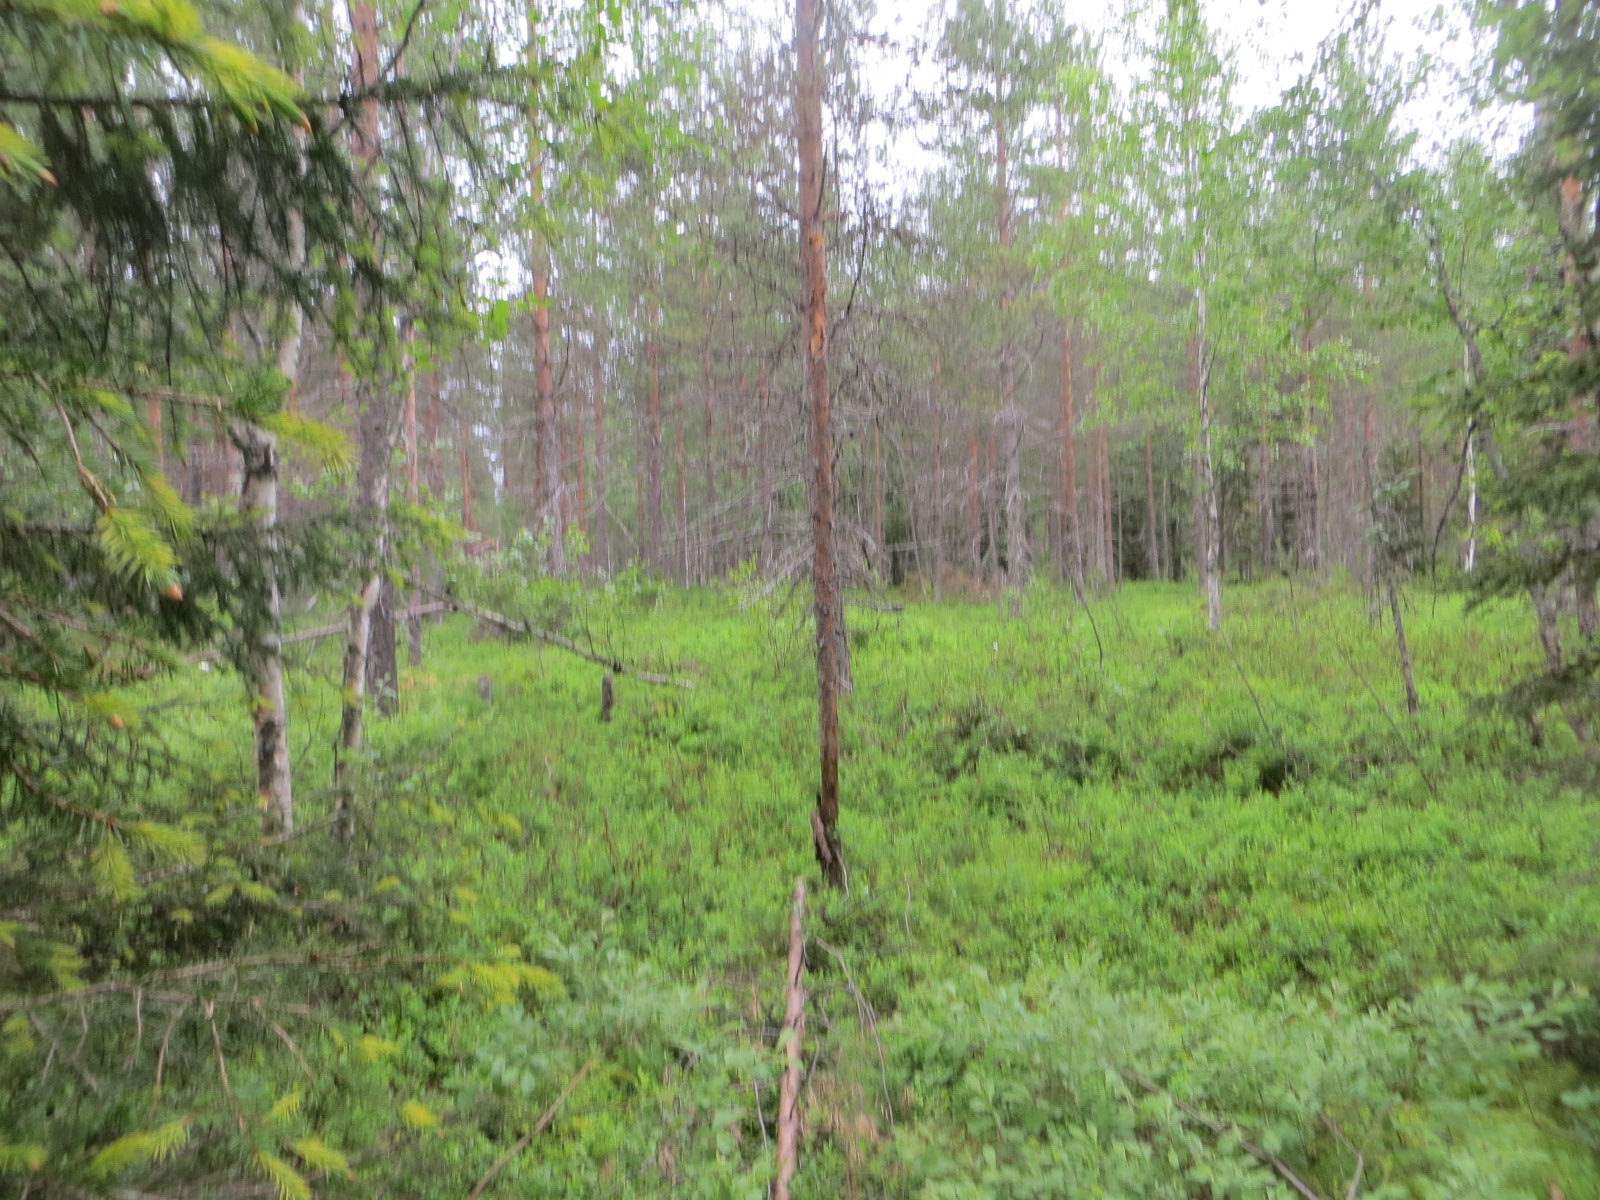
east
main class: Woodland
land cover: Other coniferous woodland
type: boreal forest
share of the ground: 50 - 75 %
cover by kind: coniferous forest trees 60 %, shrubs 30 %, broadleaved forest trees 10 %
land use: Forestry
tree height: > 5 m
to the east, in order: Other coniferous woodland; Pine dominated coniferous woodland; Shruby margins; Ditches and canals; Grass margins; Tracks
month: July
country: FI
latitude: 65.7339
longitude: 25.3576
